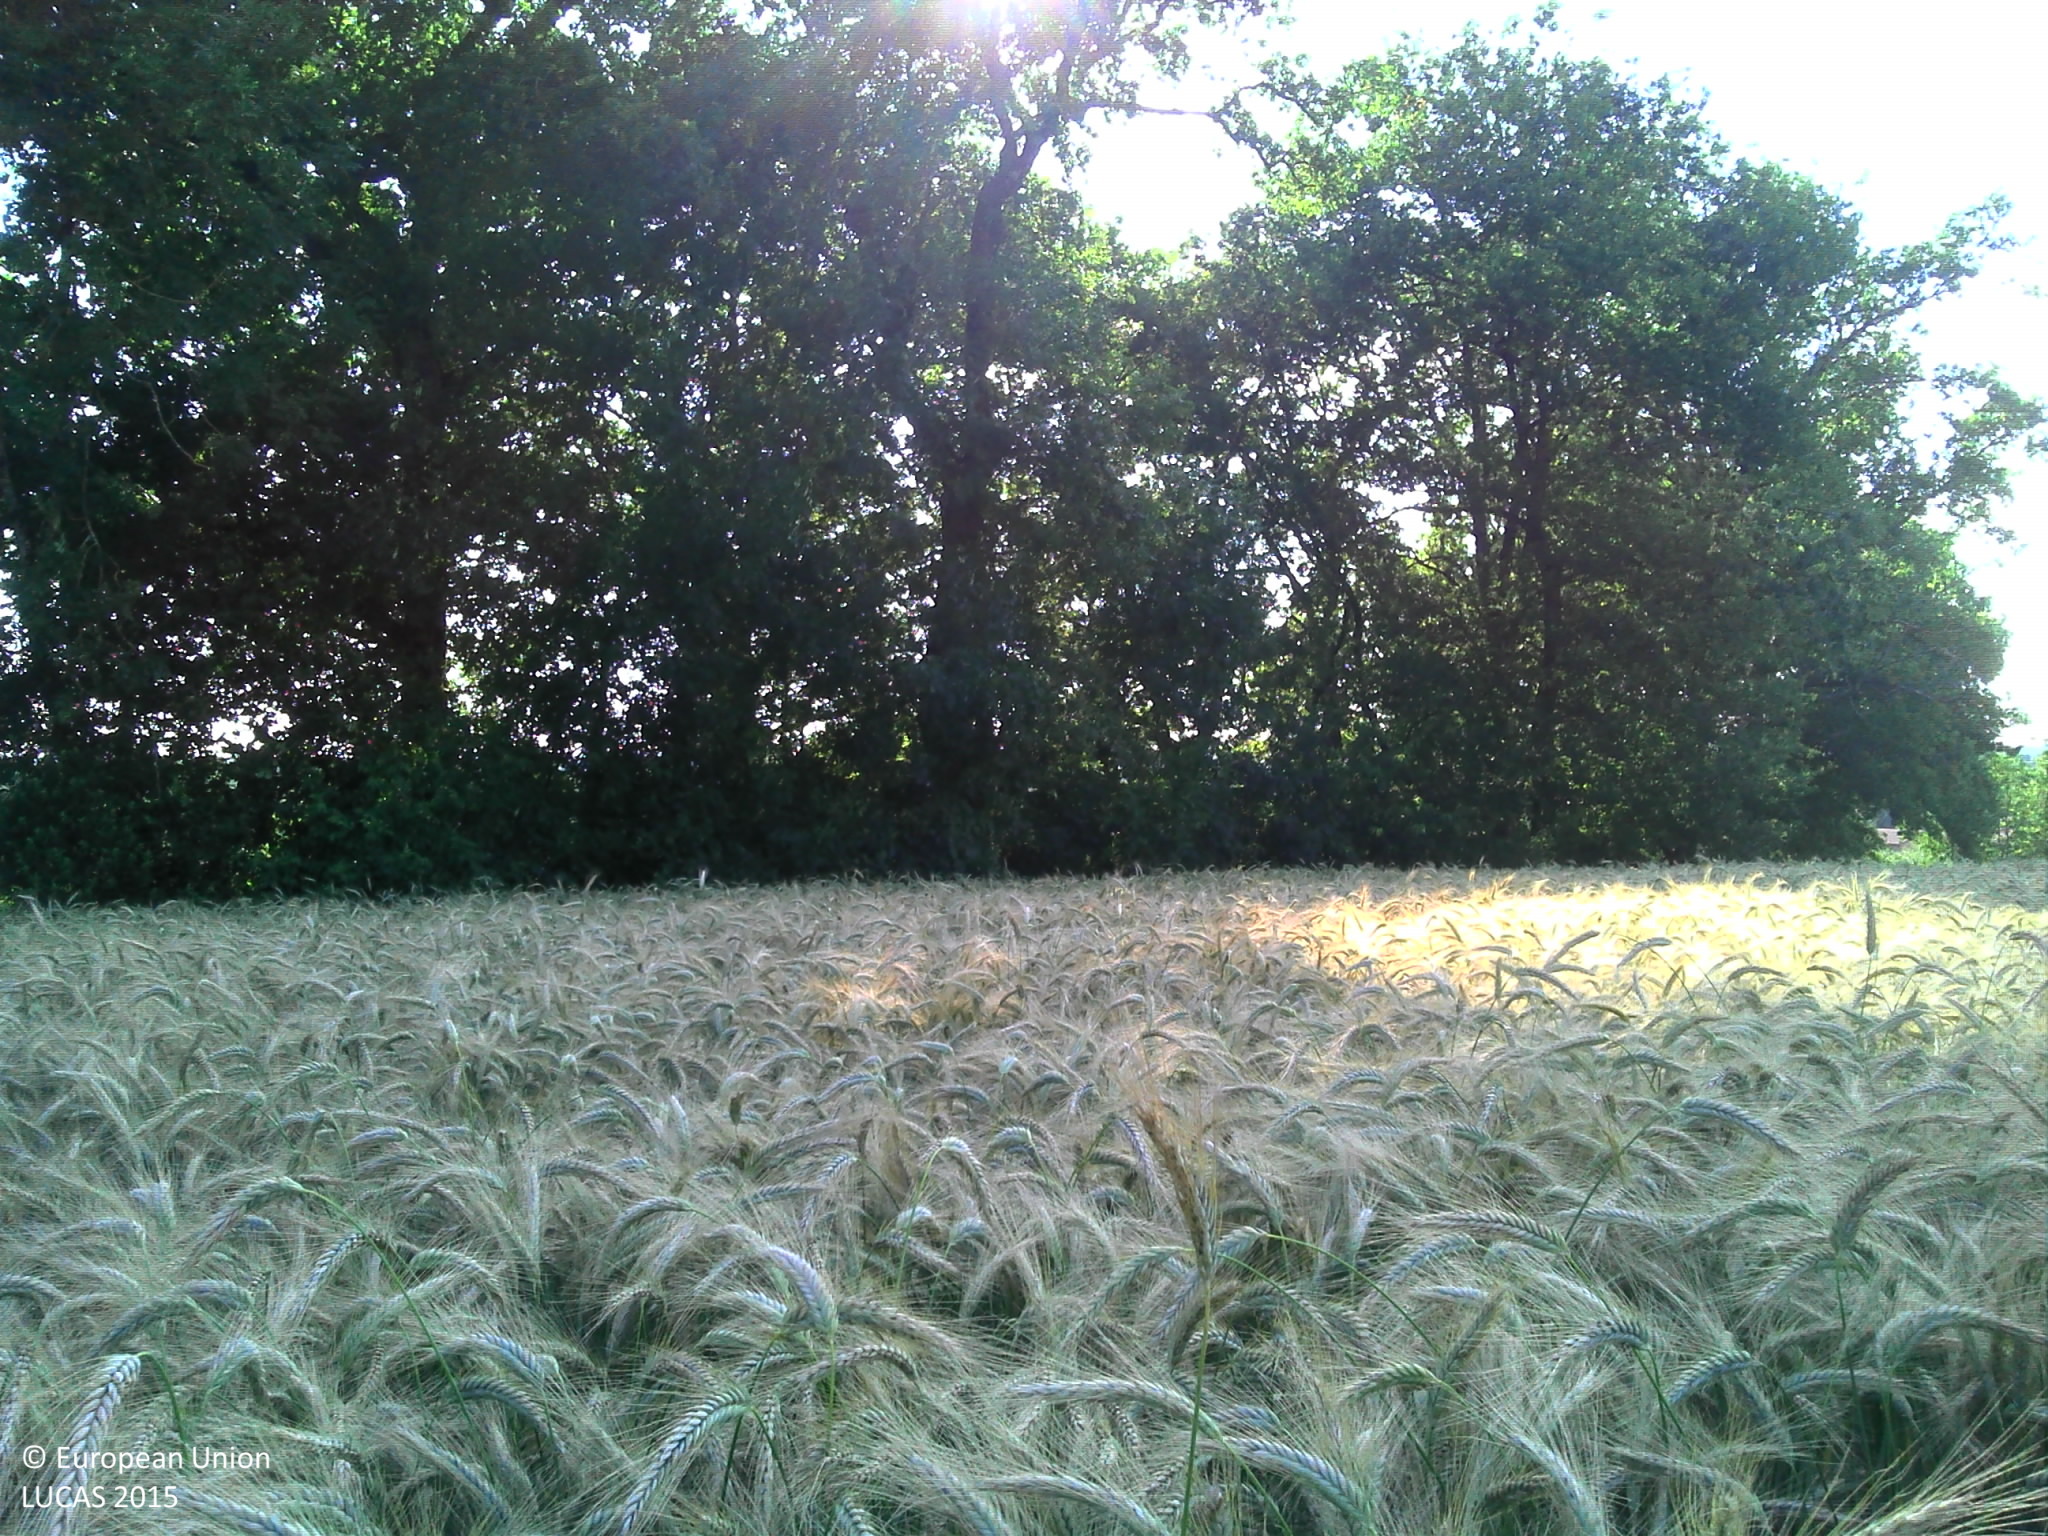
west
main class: Cropland
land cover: Triticale
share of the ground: > 75 %
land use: Agriculture (excluding fallow land and kitchen gardens)
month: June
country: FR
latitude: 45.9418
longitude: 0.6603
